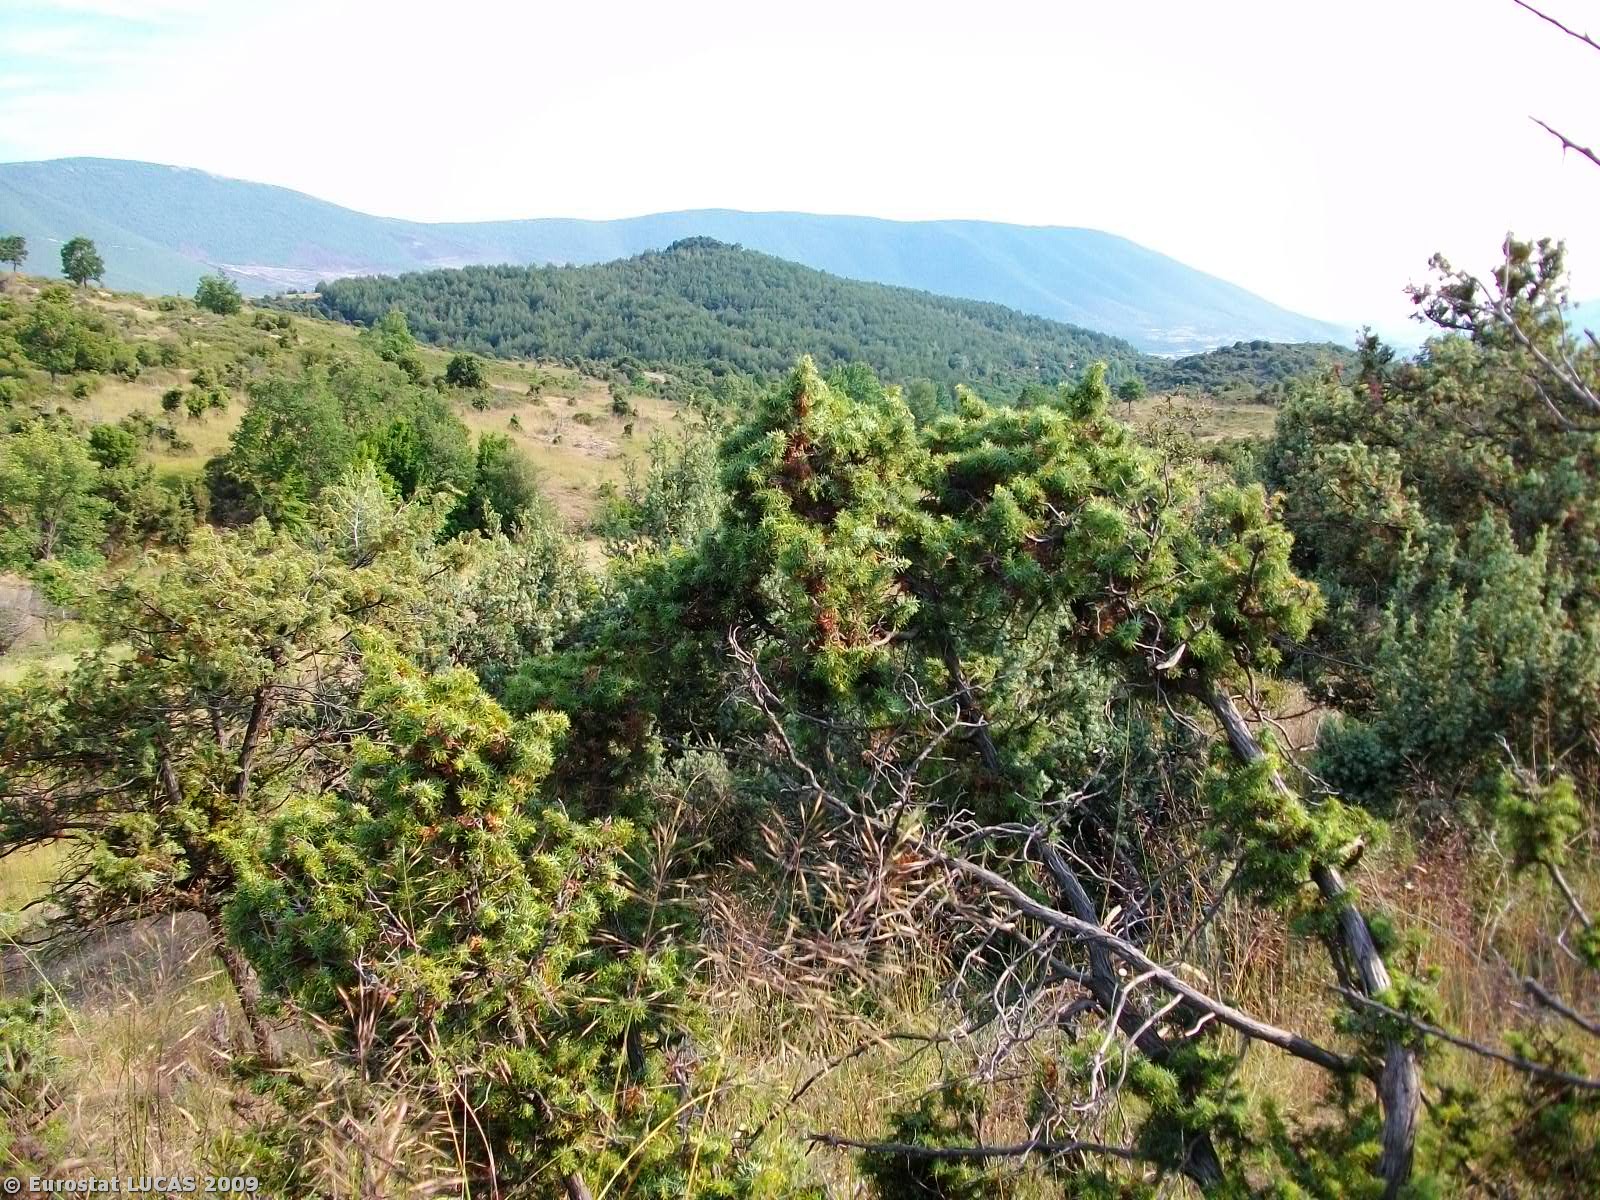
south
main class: Shrubland
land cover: Shrubland without tree cover
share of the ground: > 75 %
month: June
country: GR
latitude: 41.2149
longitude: 24.4067
